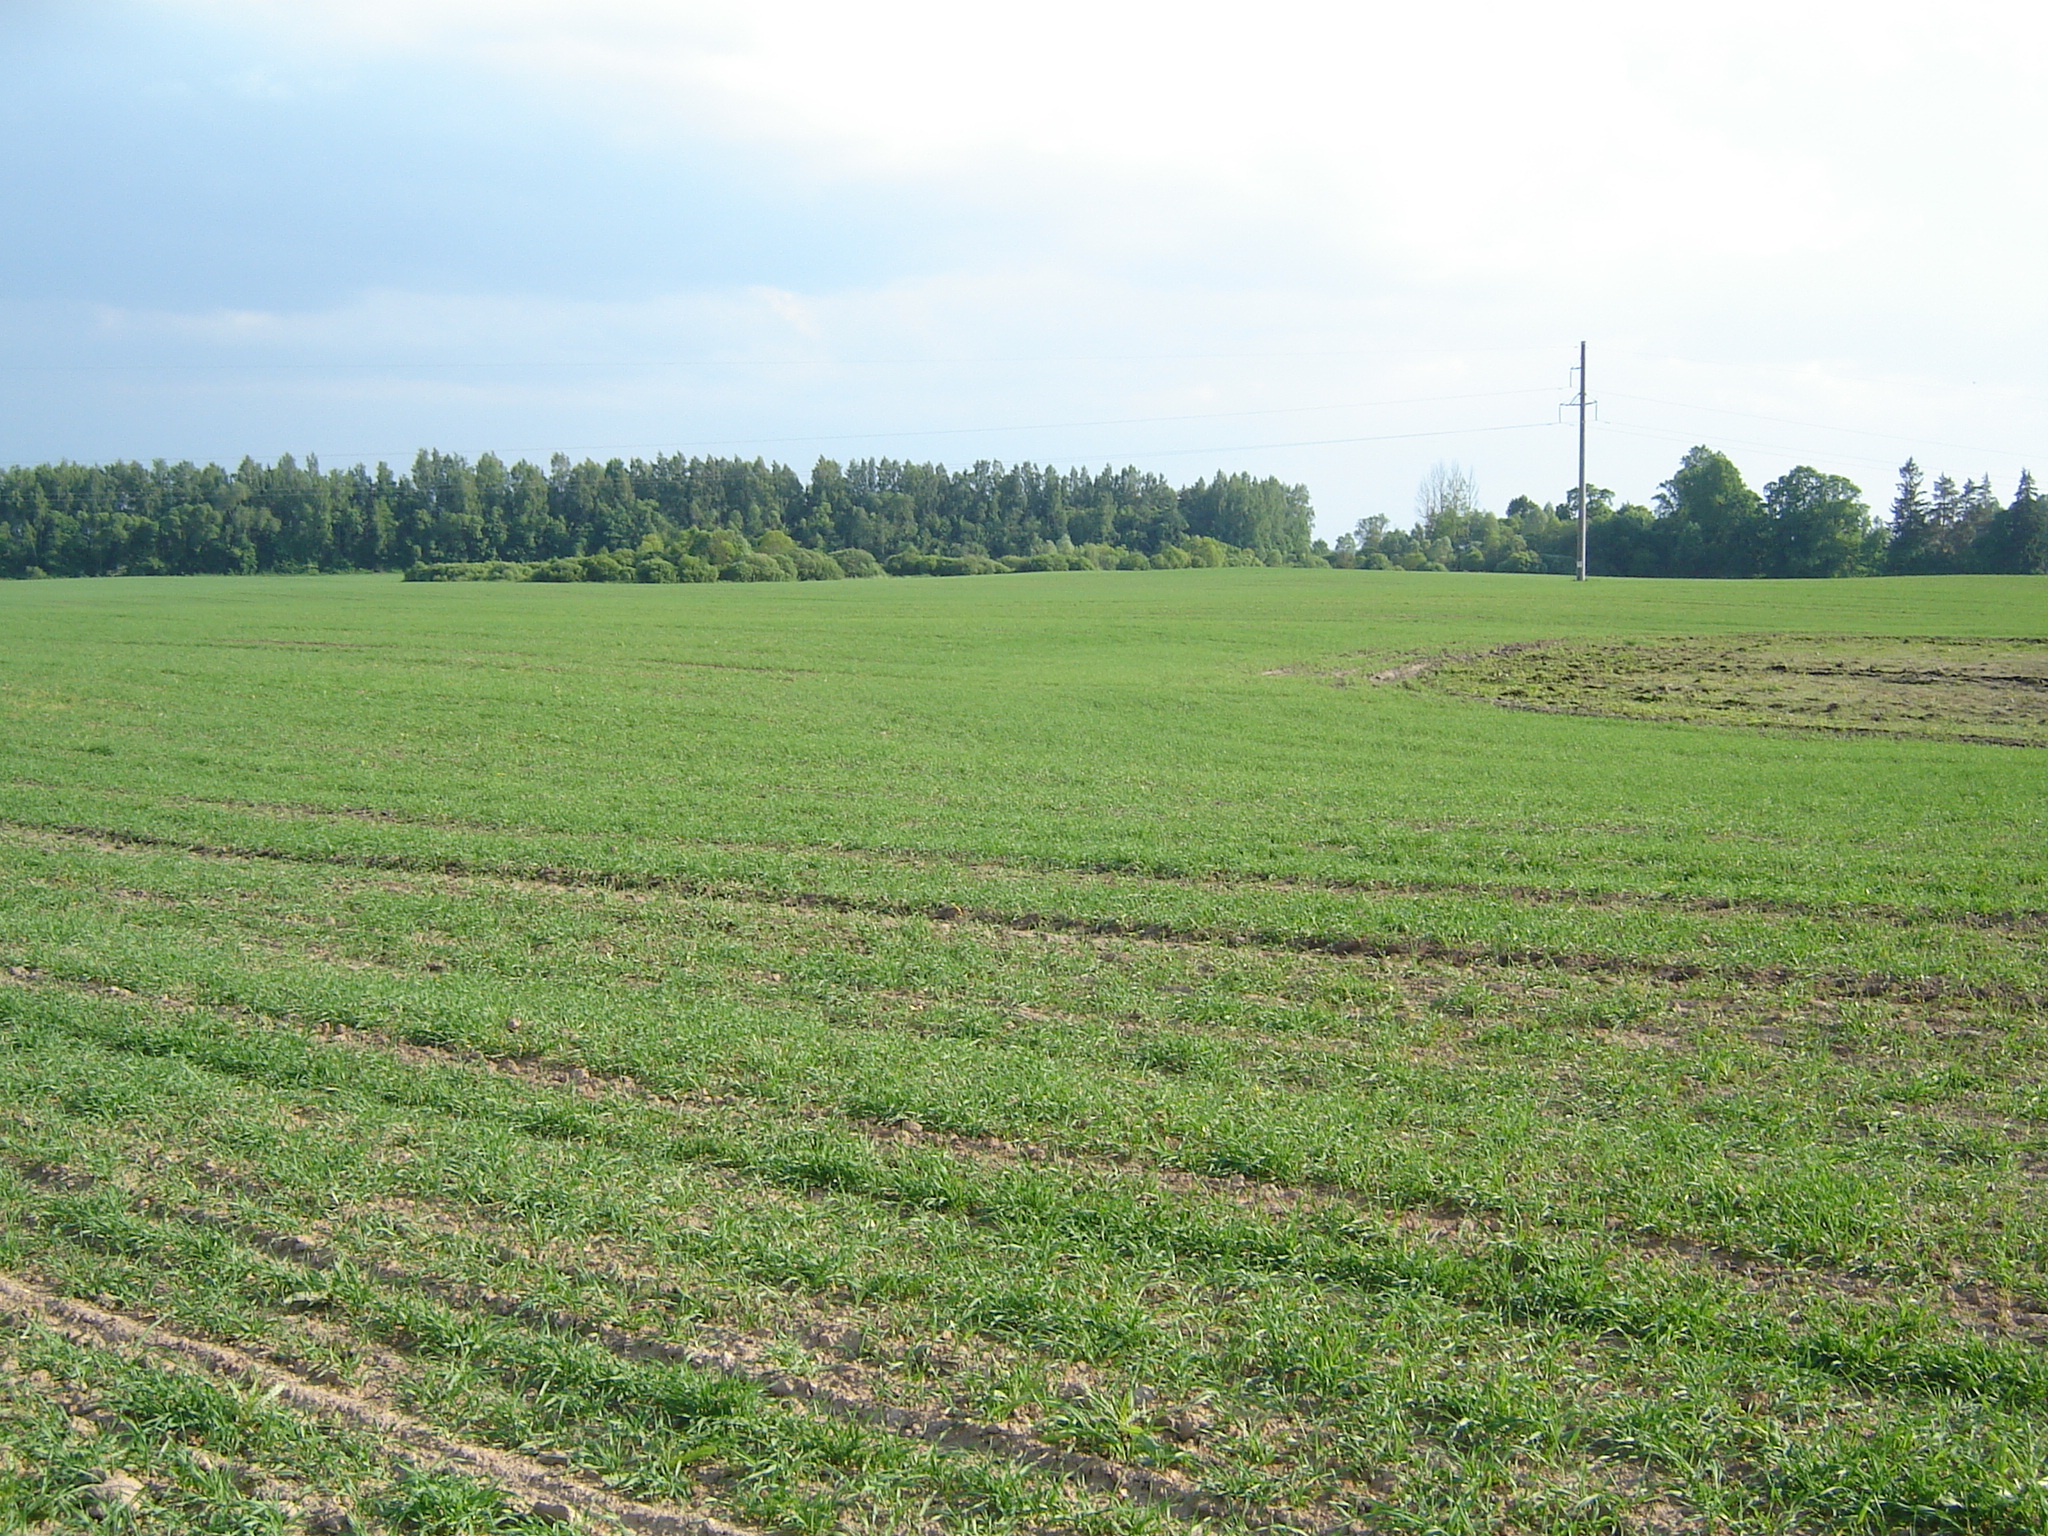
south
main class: Cropland
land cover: Barley
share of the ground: 50 - 75 %
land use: Agriculture (excluding fallow land and kitchen gardens)
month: June
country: LT
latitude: 55.8733
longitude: 25.2519
